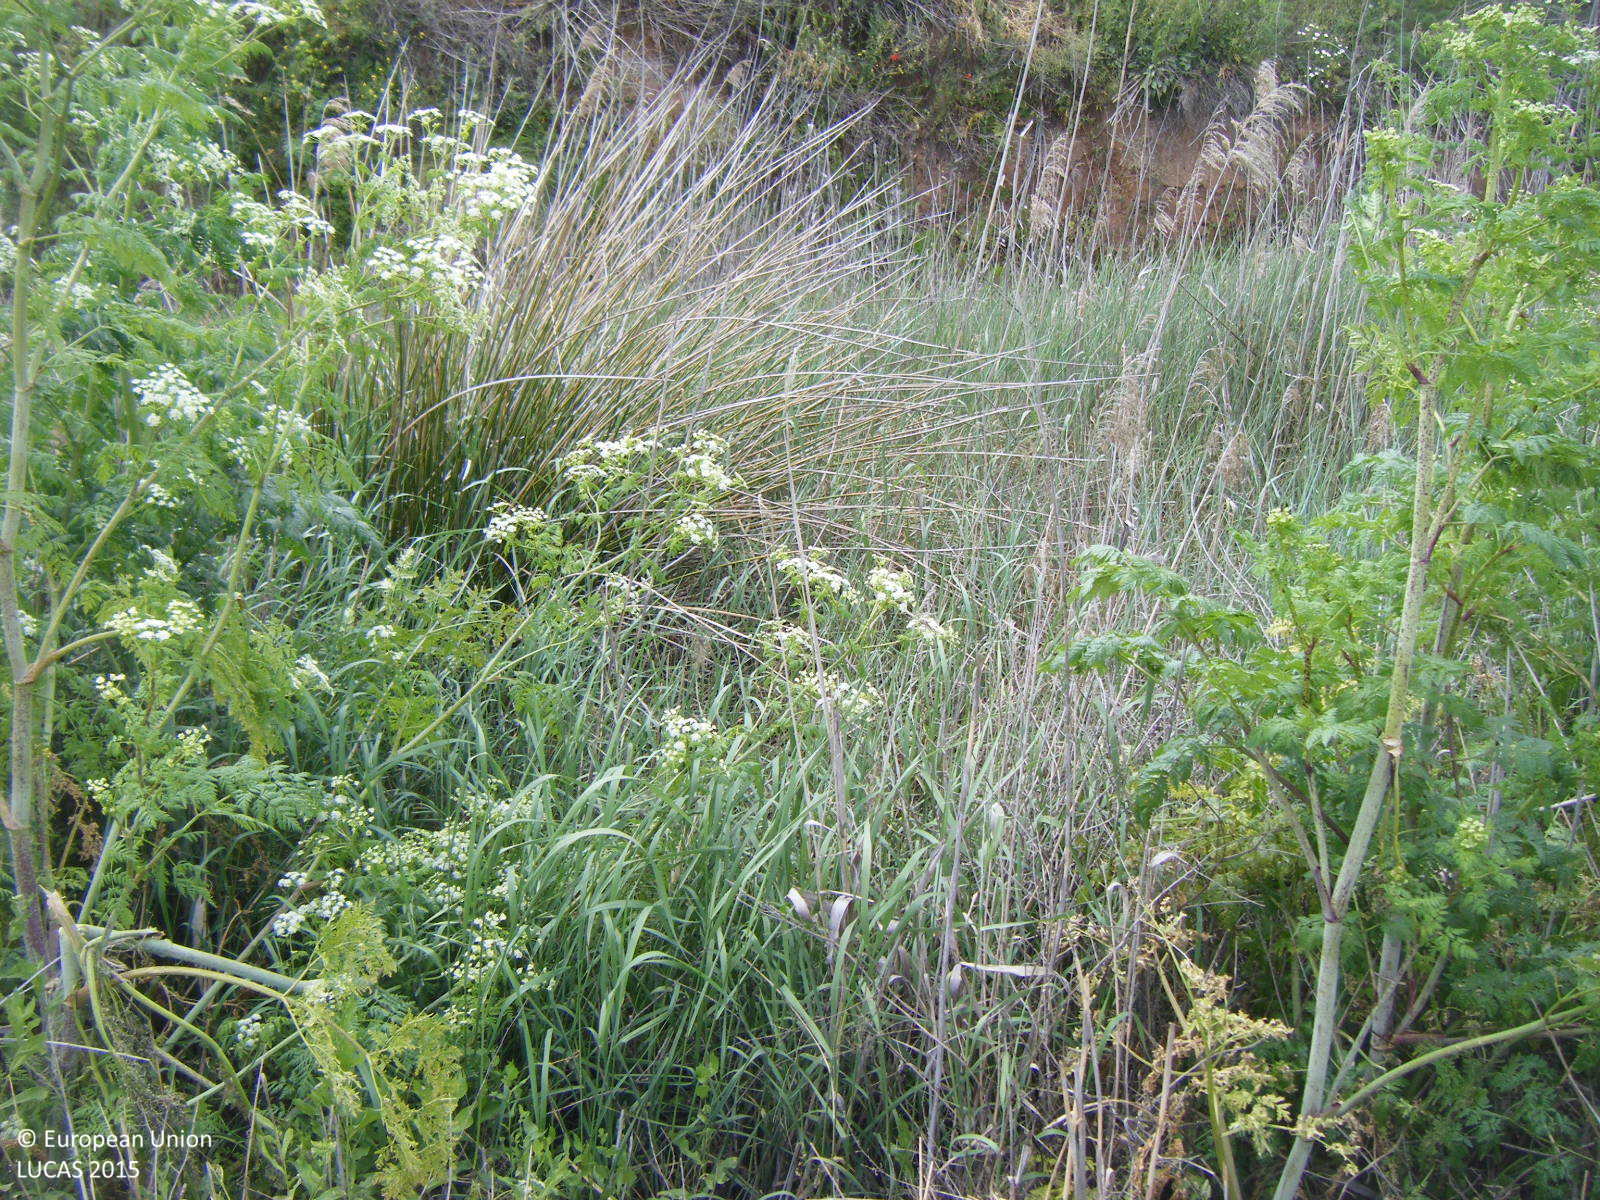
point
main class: Grassland
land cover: Grassland without tree/shrub cover
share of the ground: > 75 %
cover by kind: herbaceous plants 100 %
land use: Semi-natural and natural areas not in use
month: April
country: ES
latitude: 37.0306
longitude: -4.7594
